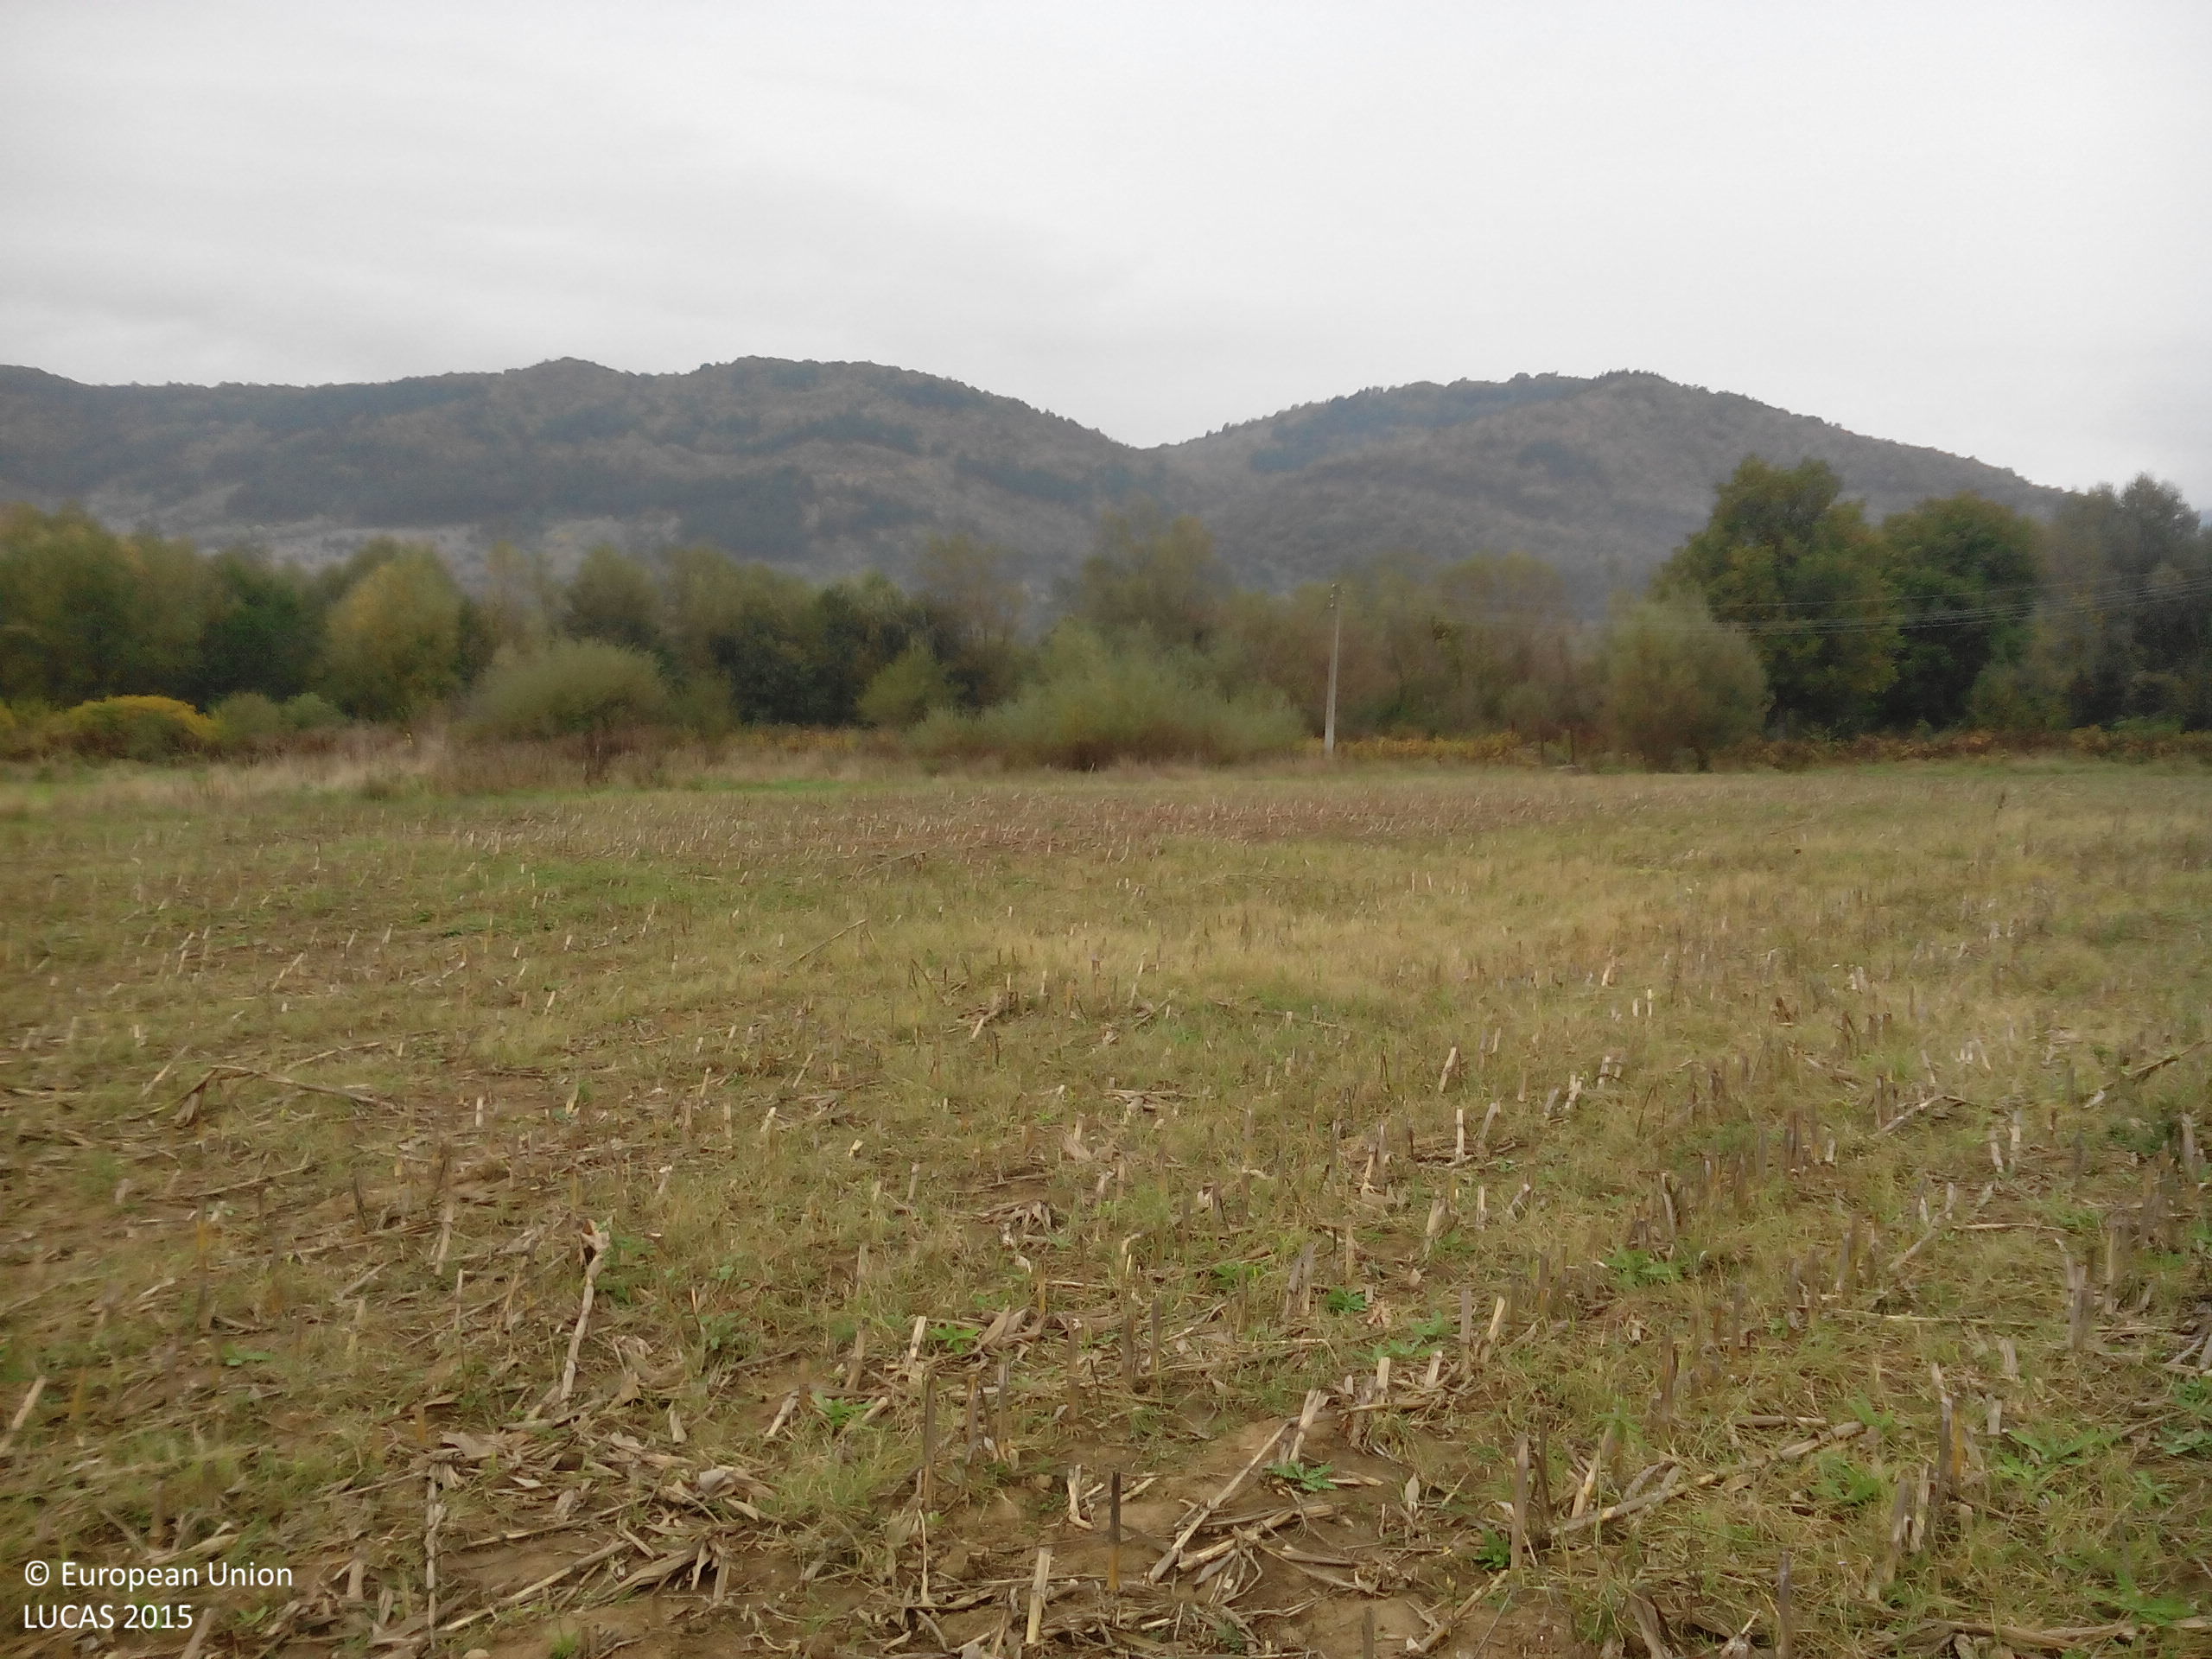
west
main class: Cropland
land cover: Maize
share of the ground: < 10 %
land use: Agriculture (excluding fallow land and kitchen gardens)
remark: Harvested field
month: October
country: BG
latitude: 42.9912
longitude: 24.0178
